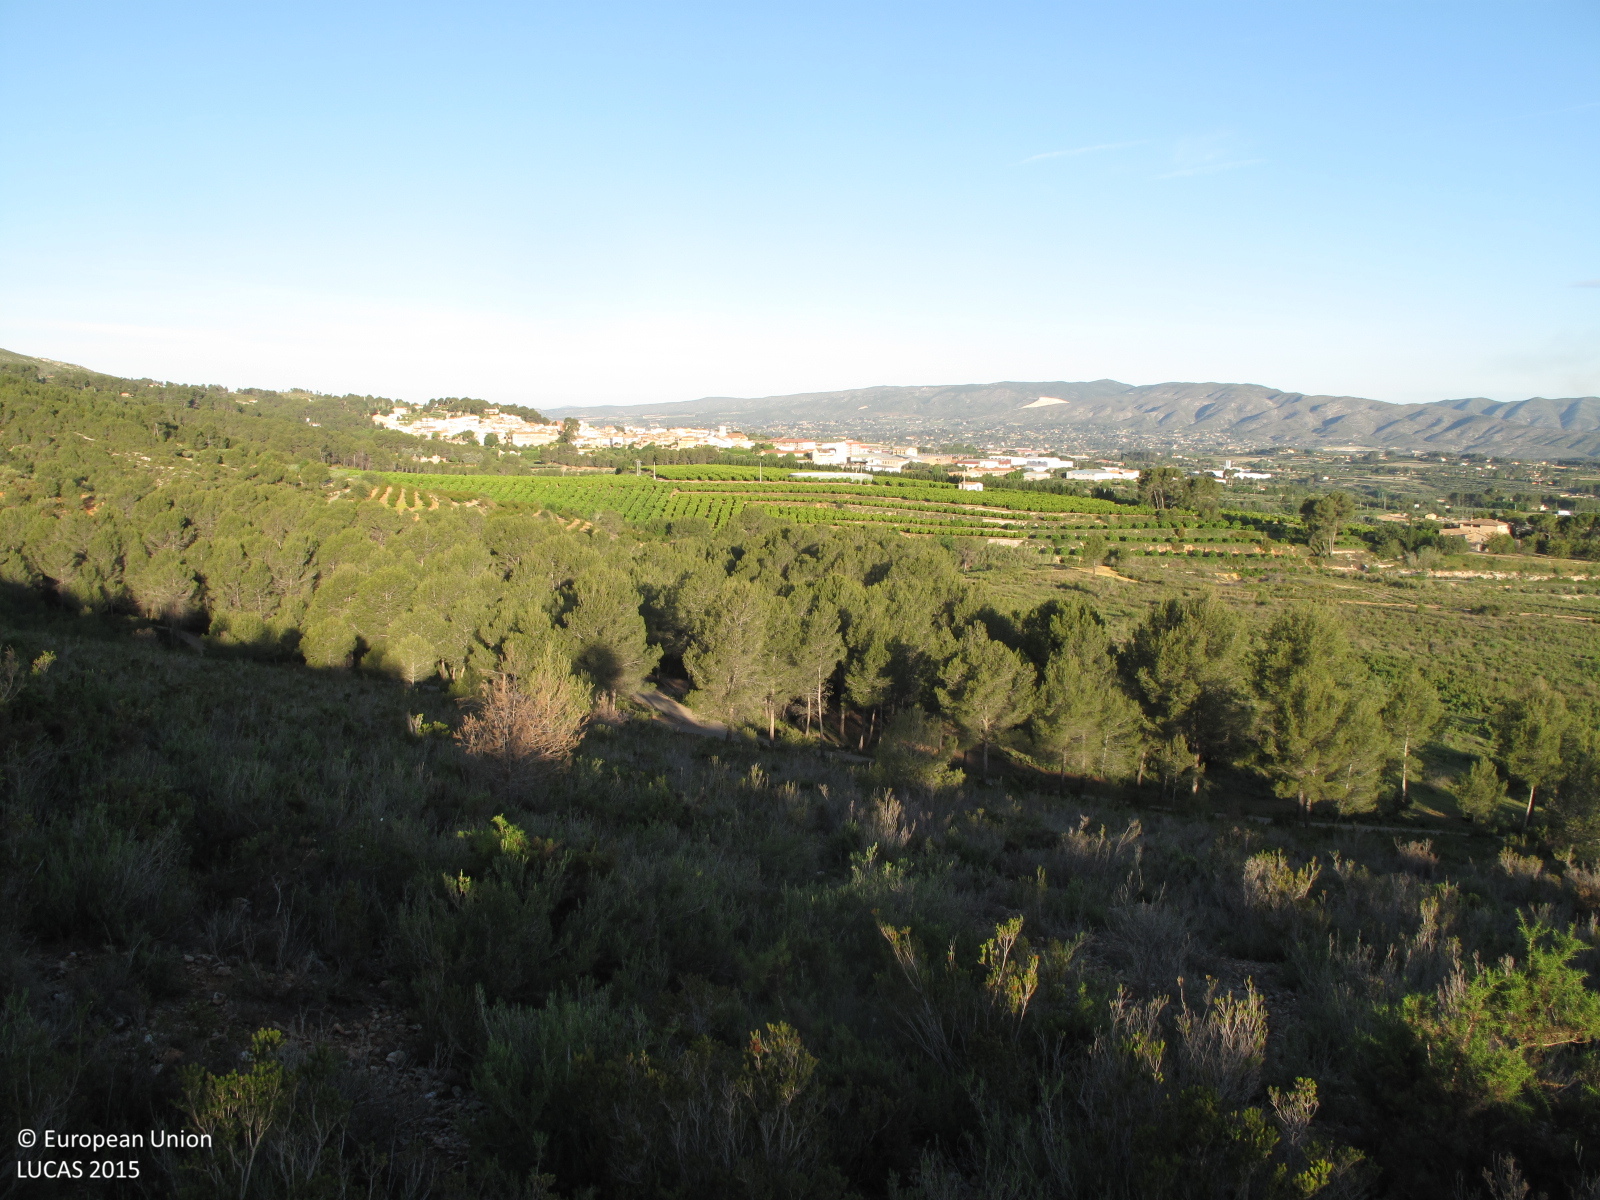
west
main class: Shrubland
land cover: Shrubland with sparse tree cover
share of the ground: > 75 %
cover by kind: shrubs 75 %, herbaceous plants 10 %, lichens and mosses 10 %, coniferous forest trees 5 %
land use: Semi-natural and natural areas not in use
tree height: > 5 m
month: May
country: ES
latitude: 38.8234
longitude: -0.5300
